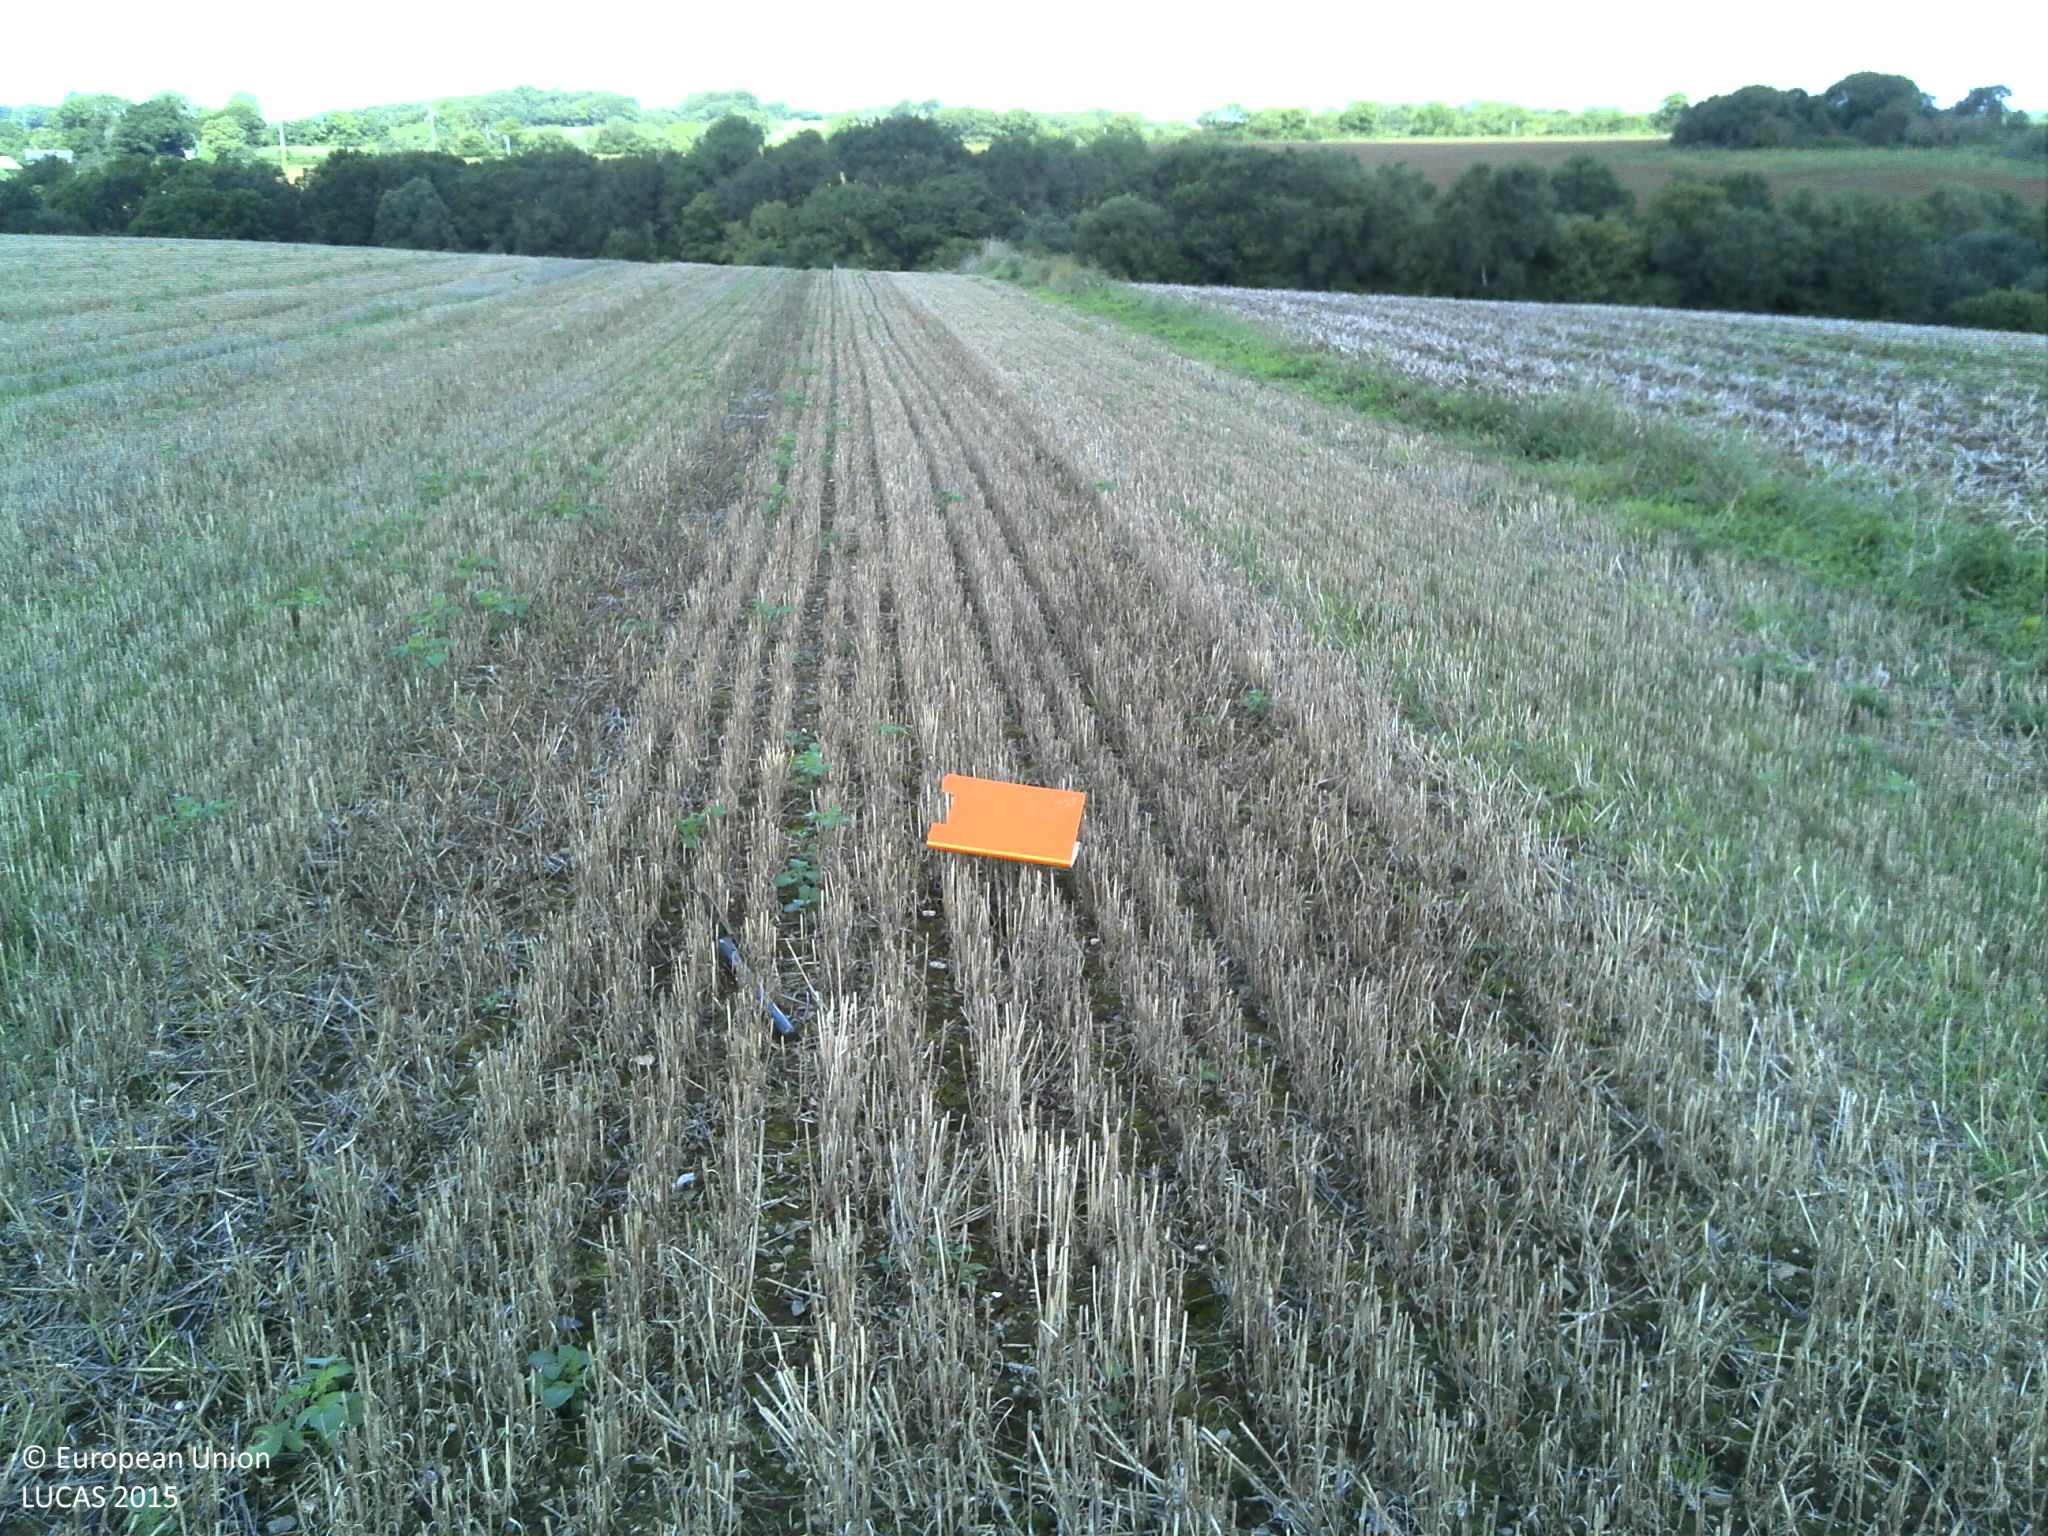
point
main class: Cropland
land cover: Durum wheat
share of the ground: > 75 %
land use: Agriculture (excluding fallow land and kitchen gardens)
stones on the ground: < 10 %
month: September
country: FR
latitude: 48.3620
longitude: -4.1690
